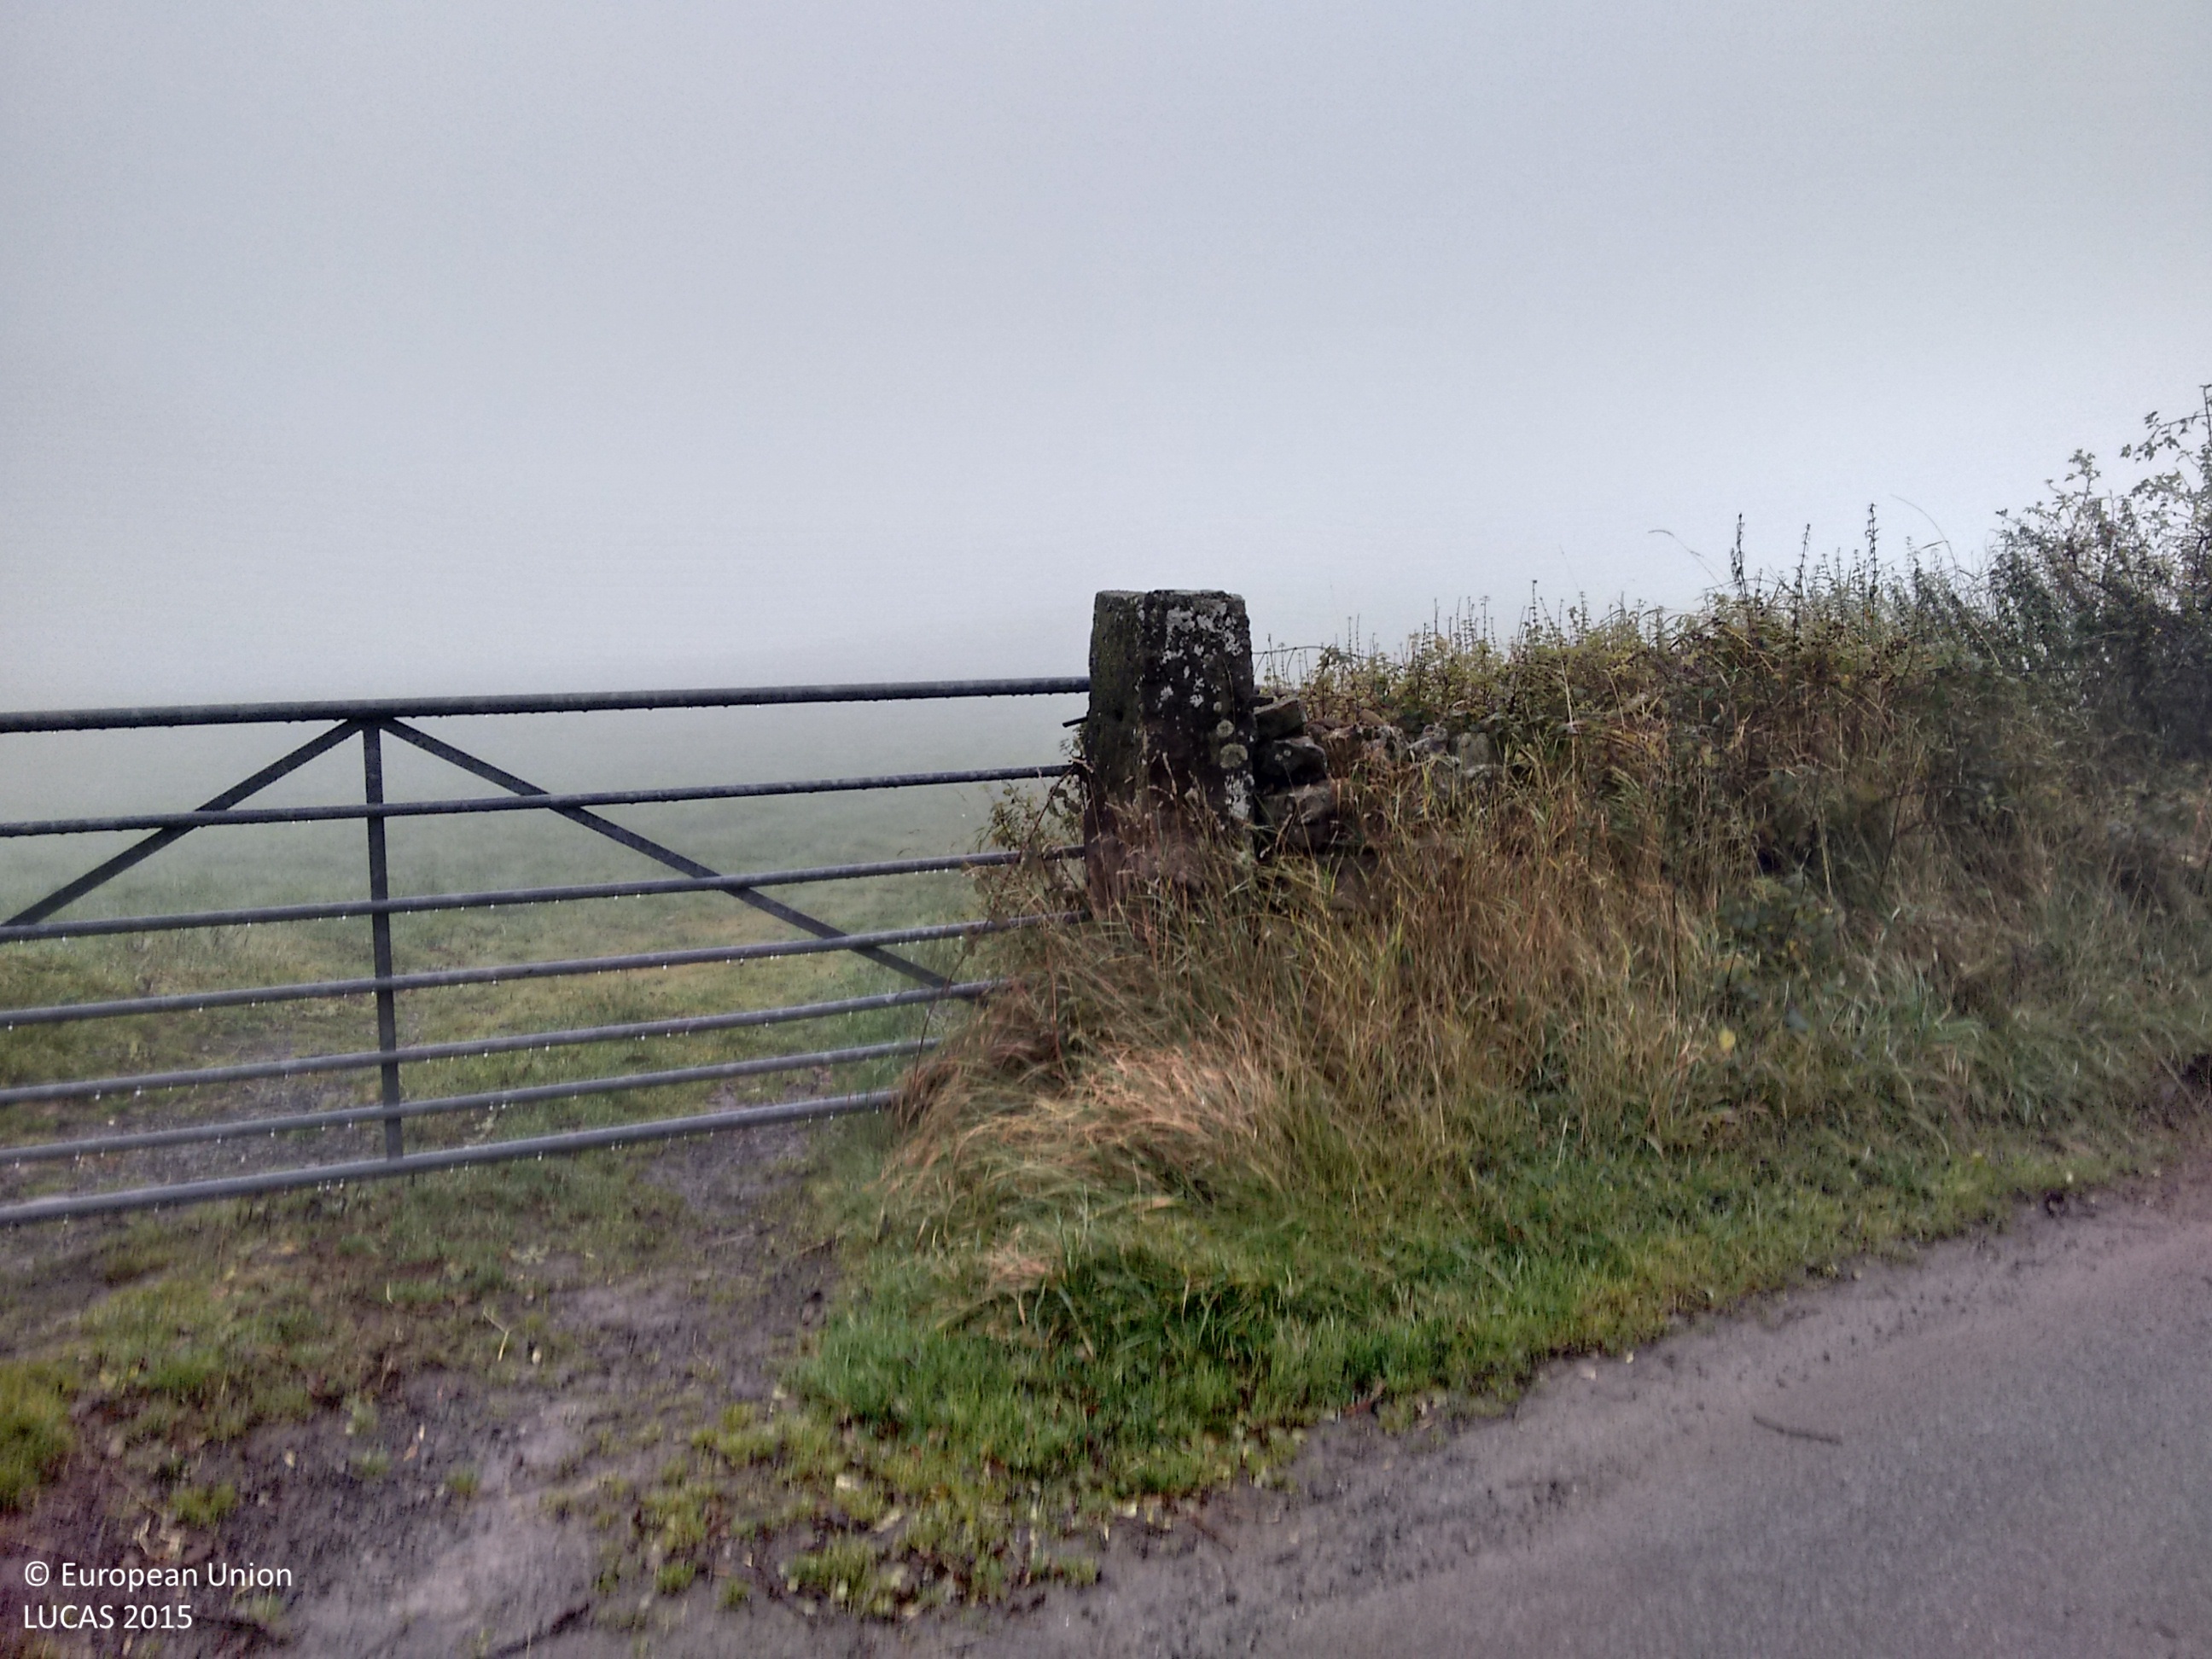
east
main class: Grassland
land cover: Grassland without tree/shrub cover
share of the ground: > 75 %
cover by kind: herbaceous plants 100 %
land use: Agriculture (excluding fallow land and kitchen gardens)
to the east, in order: Grassland without tree/shrub cover; Managed hedges; Fences; Grass margins; Paved roads, cycling and walking lanes; Grass margins; Dry stone walls; Fences; Grassland without tree/shrub cover; Fences; Grassland without tree/shrub cover
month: October
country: GB
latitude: 54.4803
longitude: -1.9547
